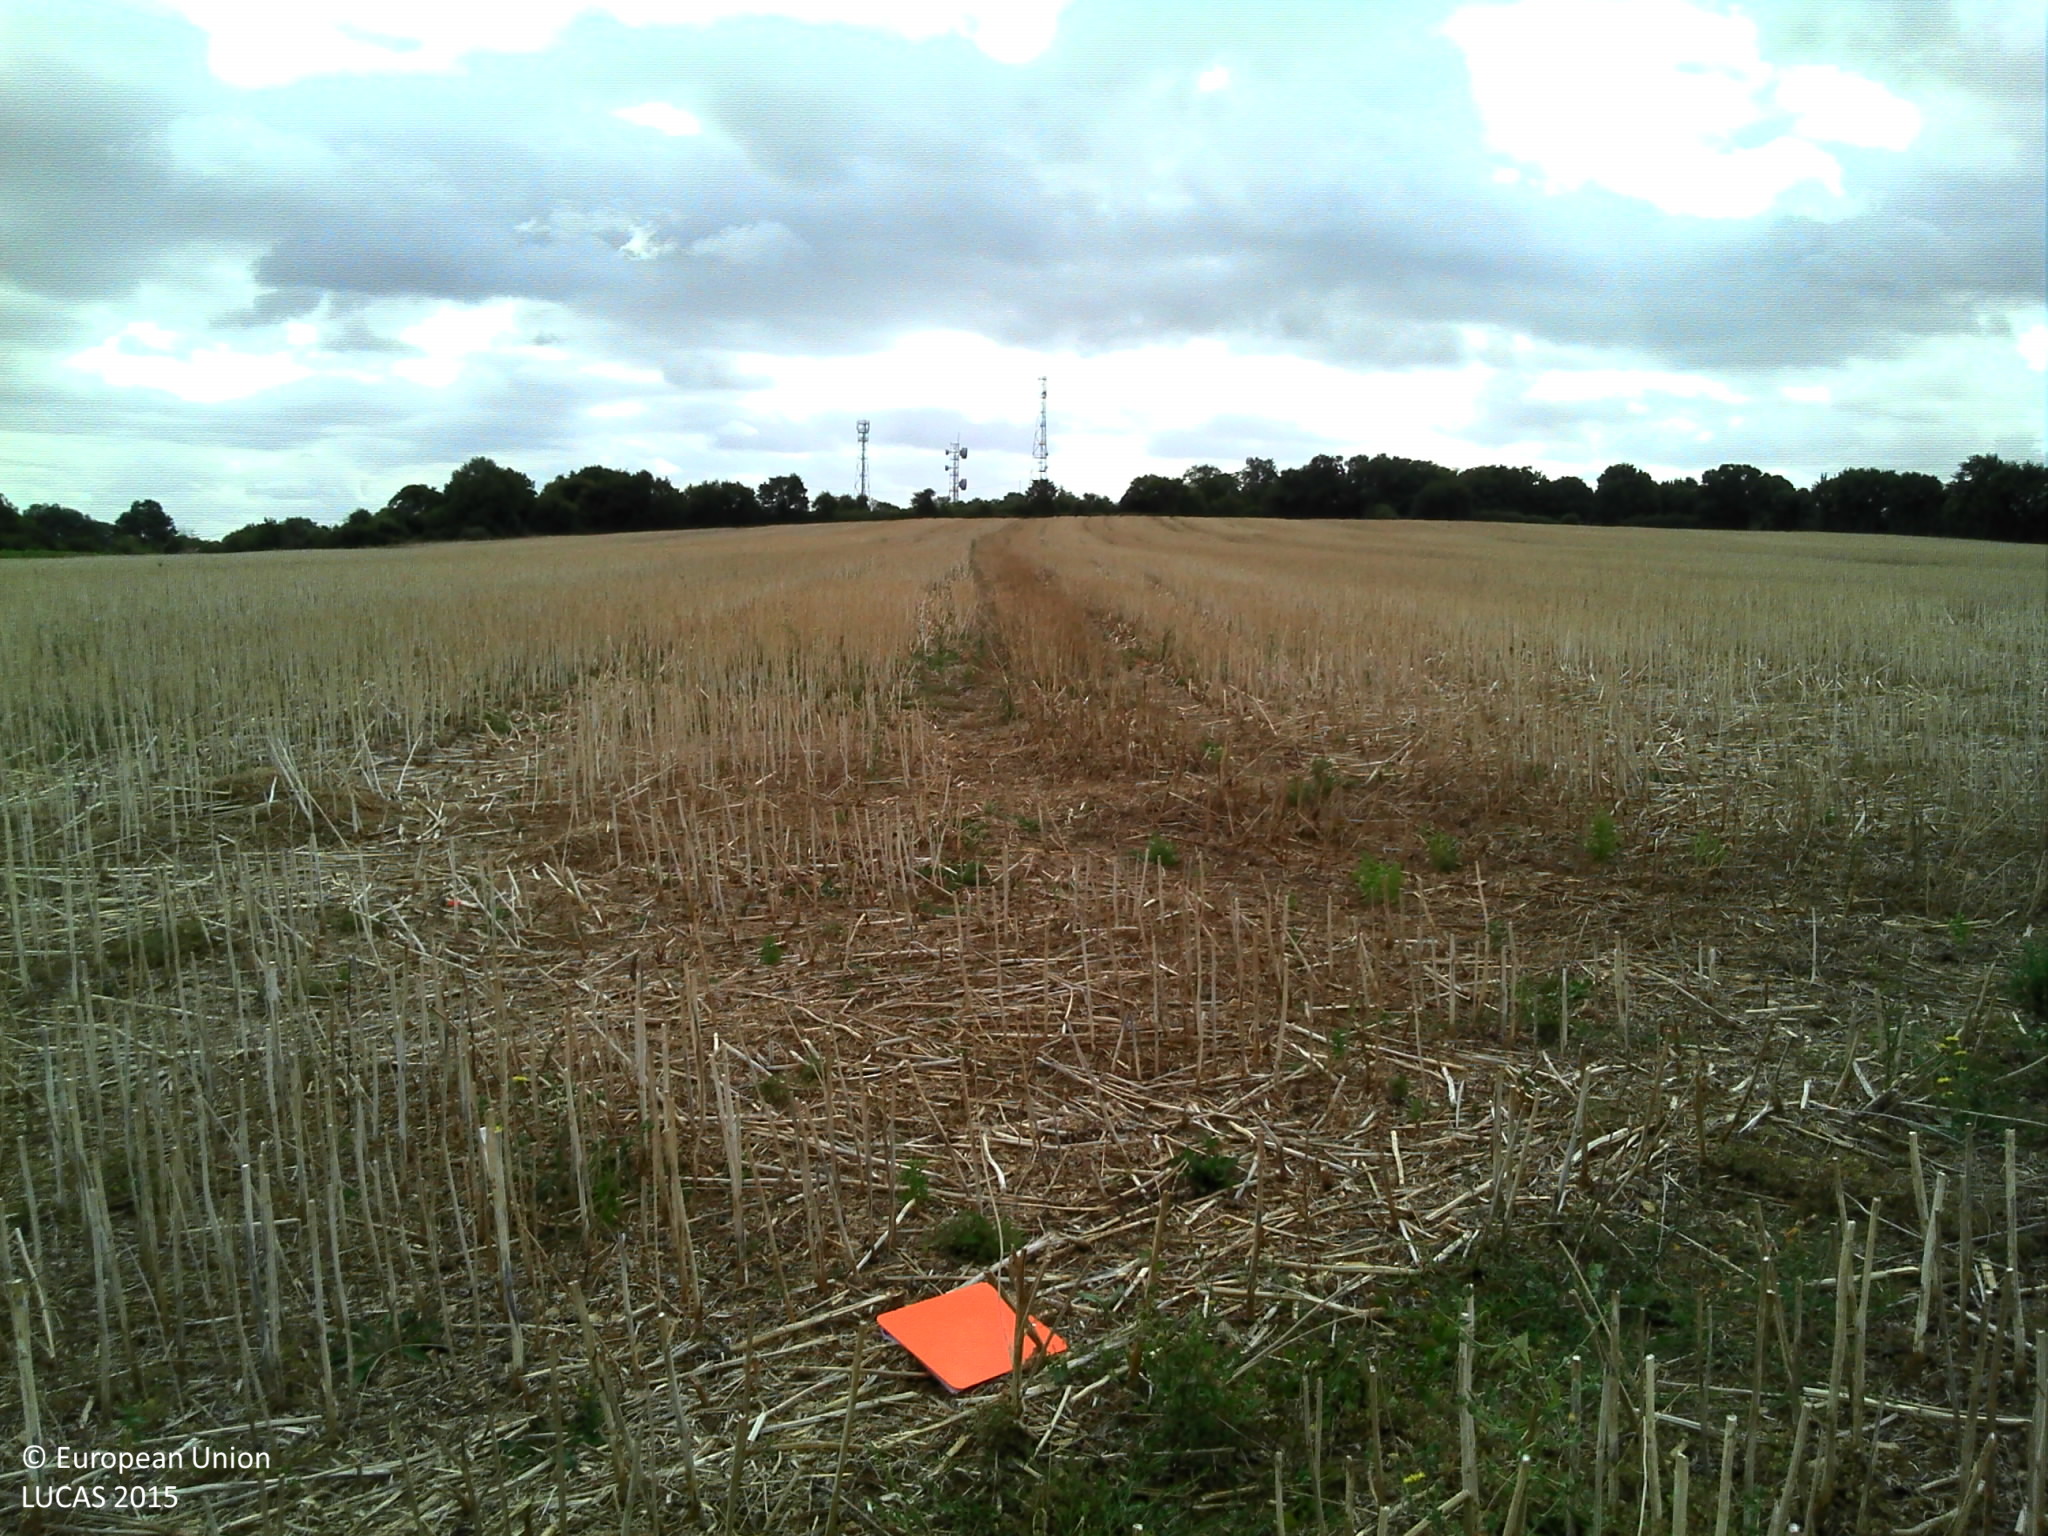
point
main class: Cropland
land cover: Rape and turnip rape
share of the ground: < 10 %
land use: Agriculture (excluding fallow land and kitchen gardens)
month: July
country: FR
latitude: 46.3269
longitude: 0.3048
